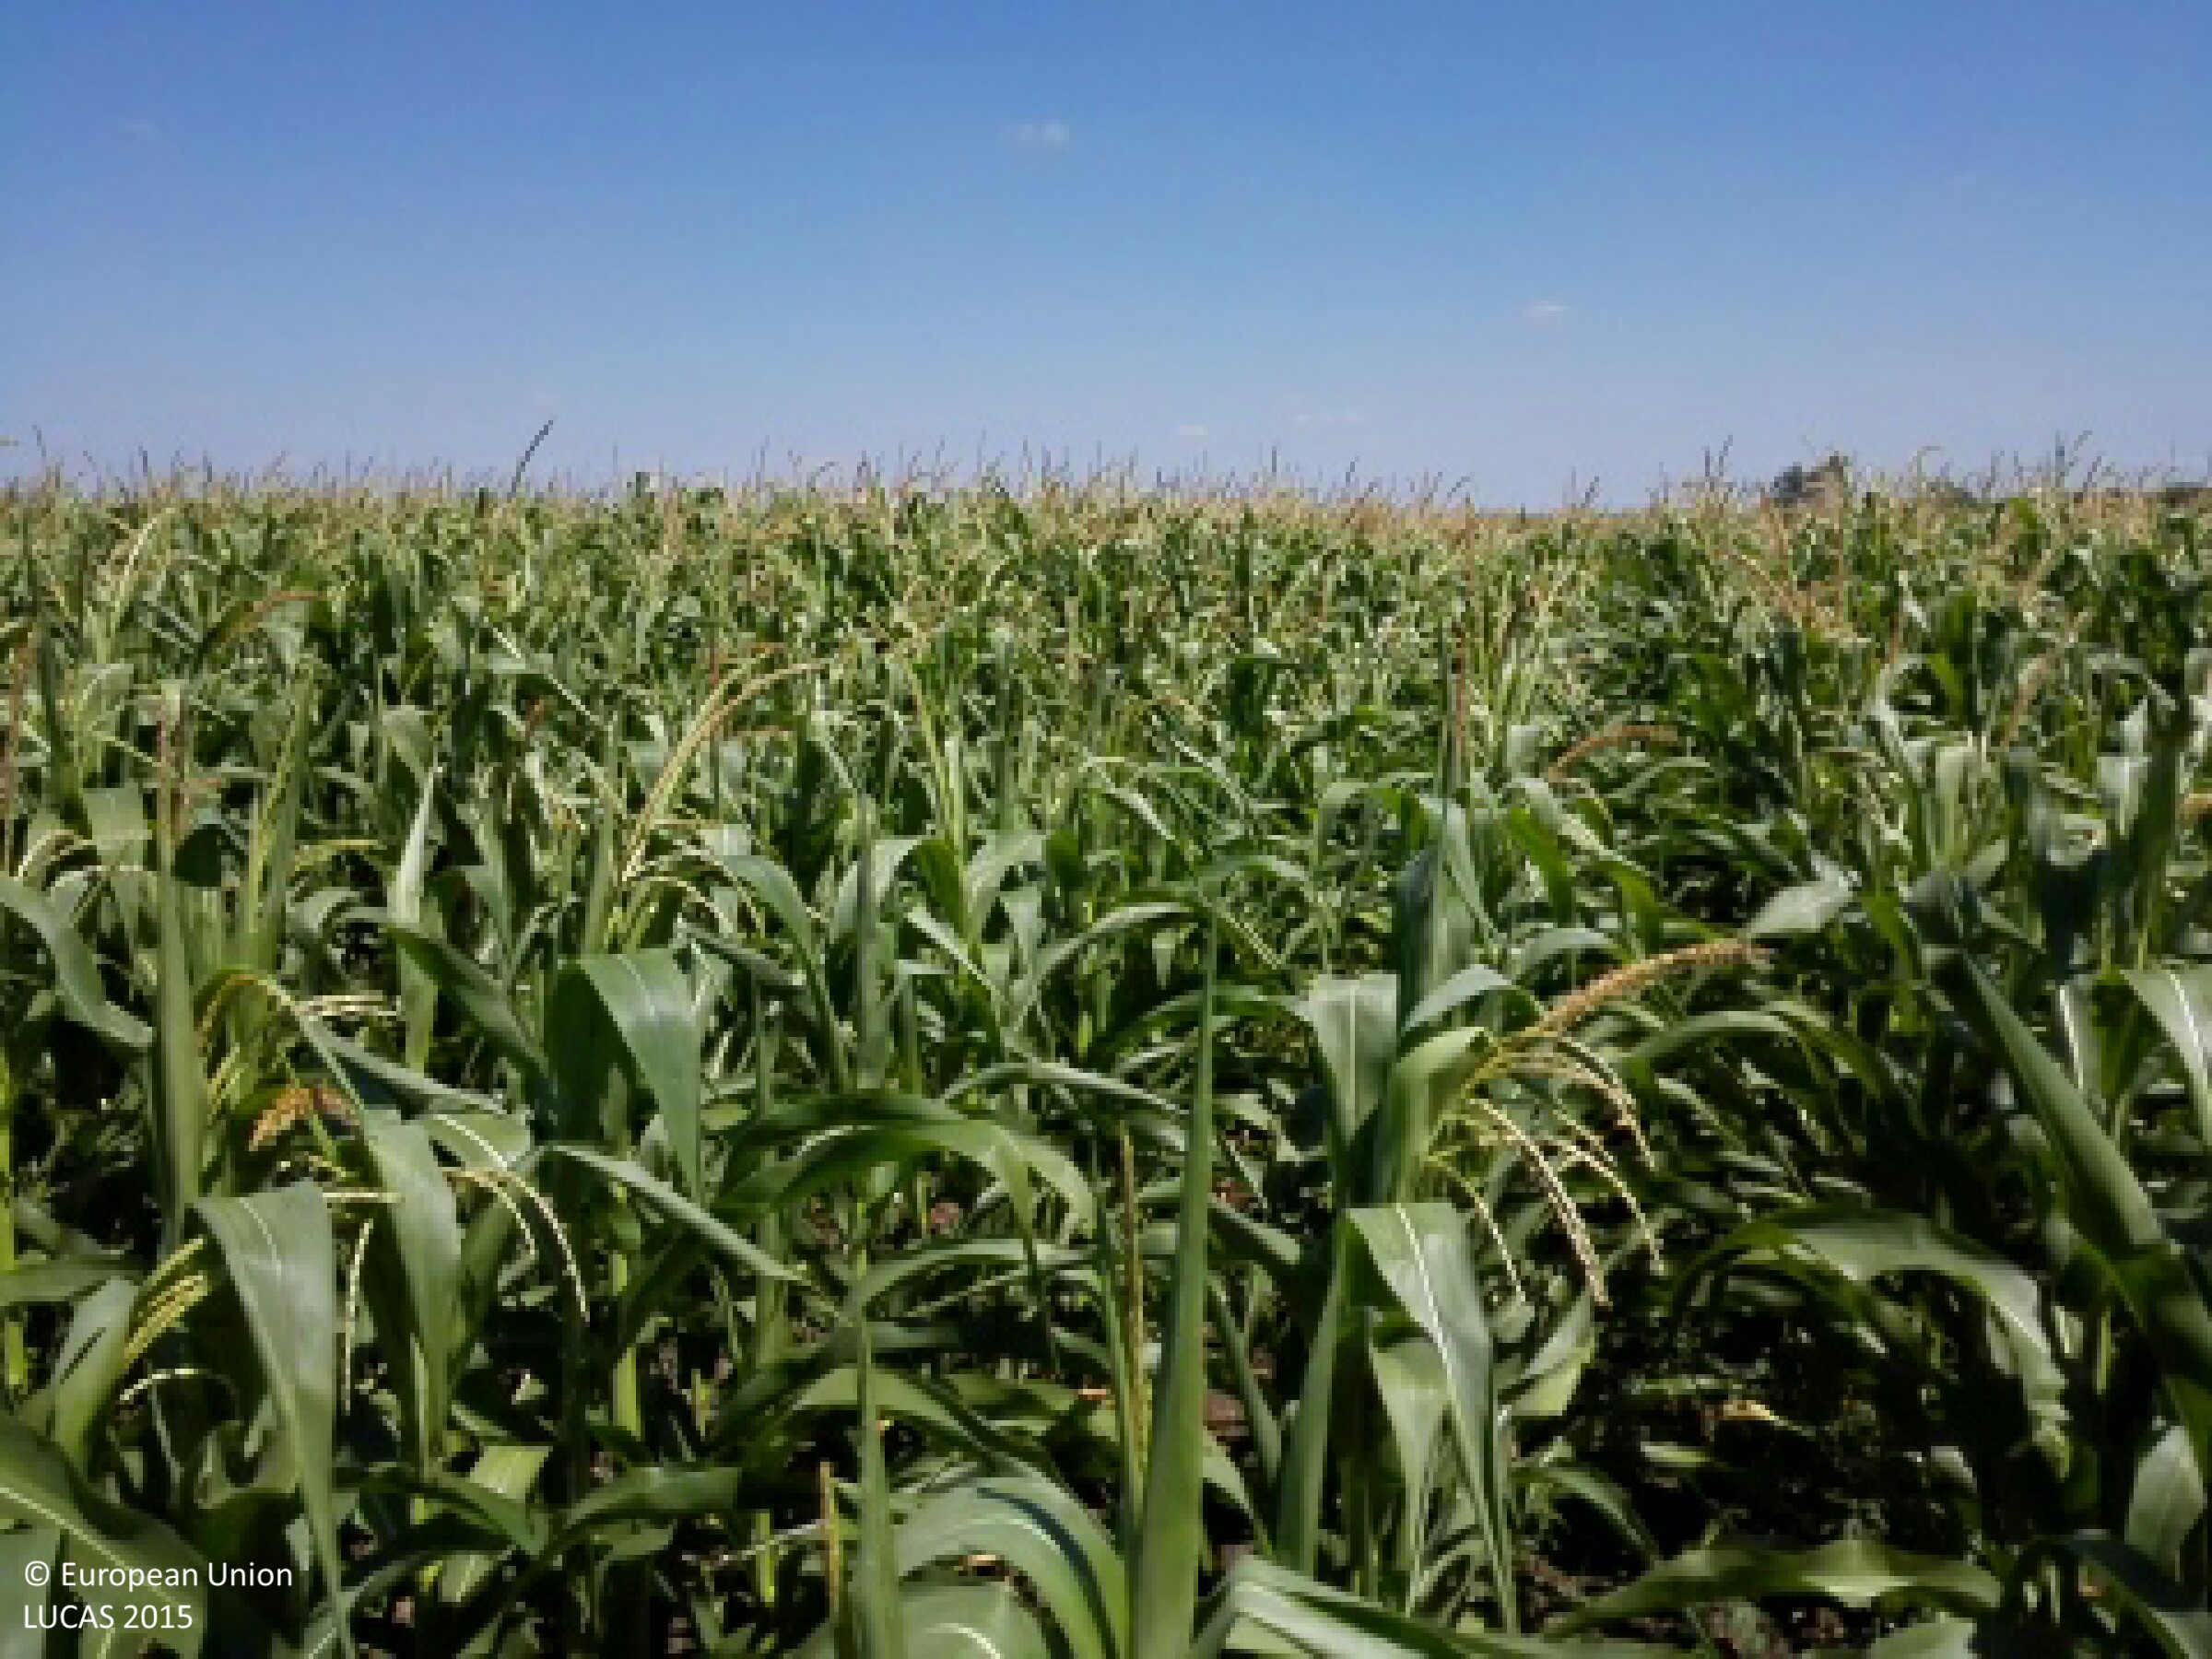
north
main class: Cropland
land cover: Maize
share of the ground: > 75 %
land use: Agriculture (excluding fallow land and kitchen gardens)
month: July
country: HU
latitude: 47.7755
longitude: 21.3994
